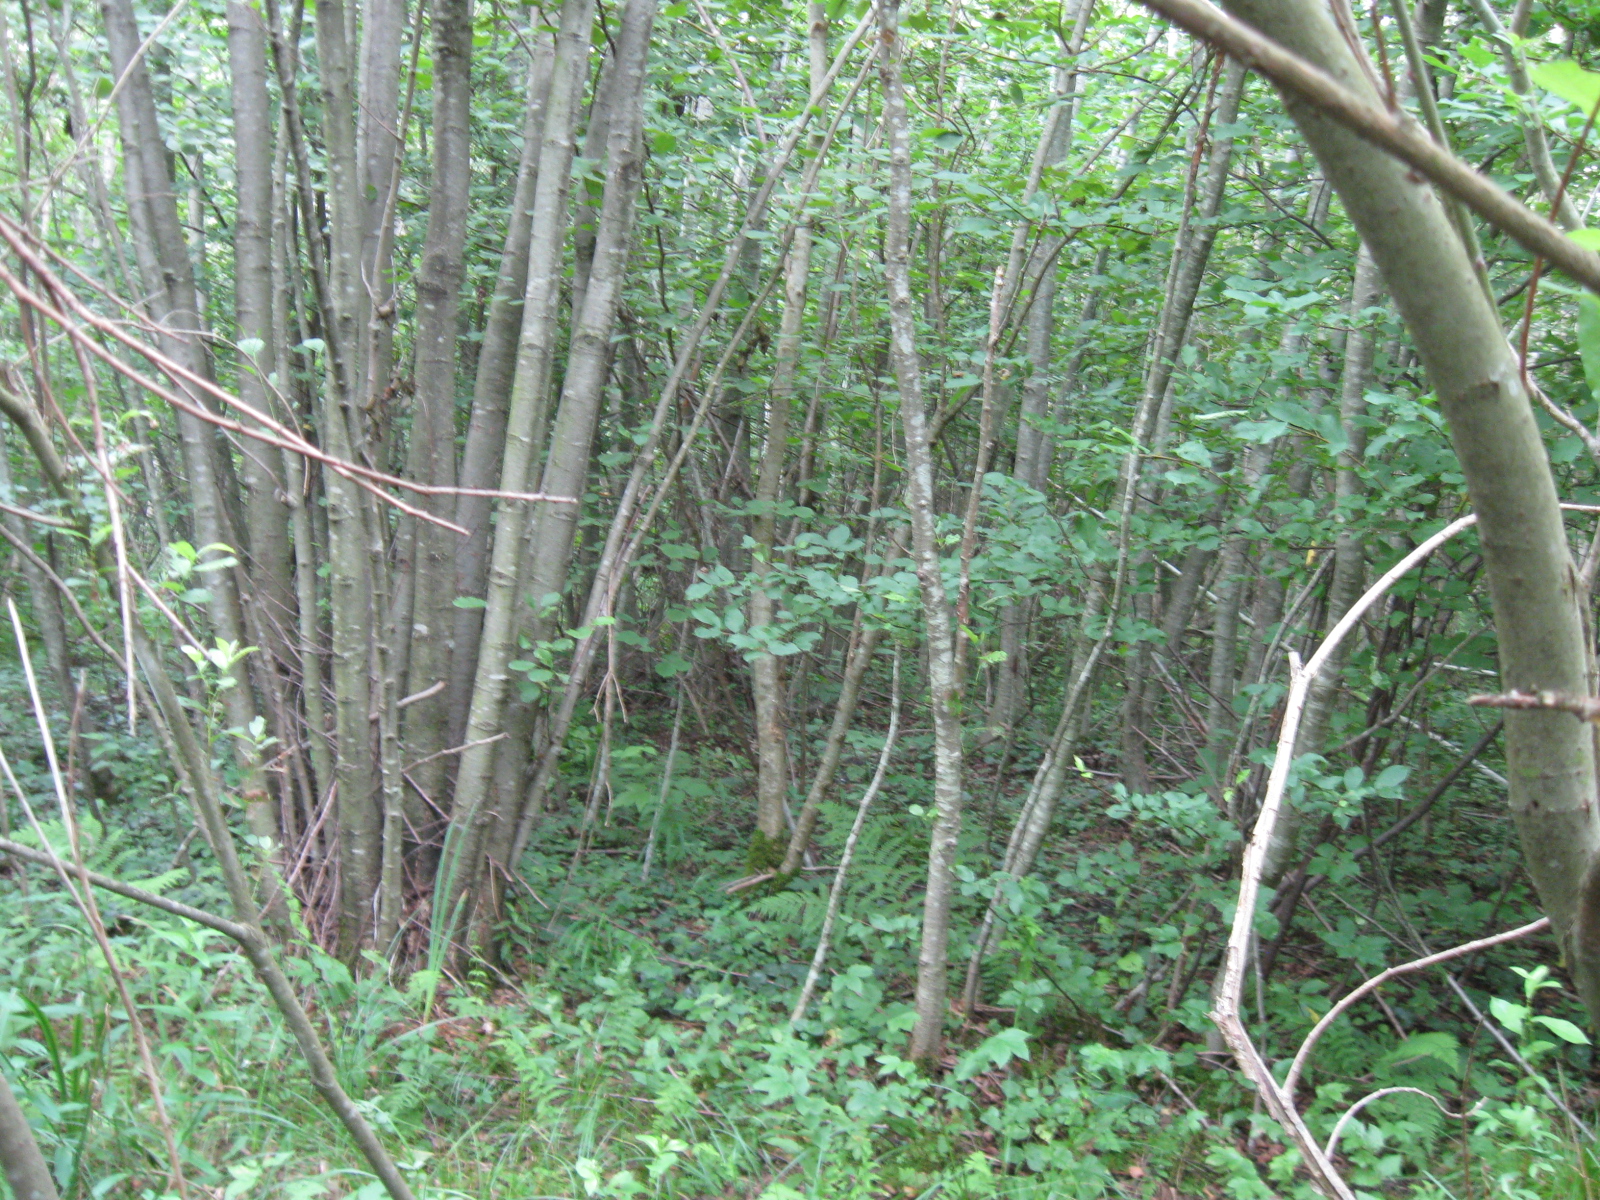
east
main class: Woodland
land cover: Broadleaved woodland
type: floodplain forest
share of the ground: > 75 %
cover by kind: broadleaved forest trees 90 %, herbaceous plants 5 %, unconsolidated bare surface 5 %
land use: Forestry
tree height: > 5 m
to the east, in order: Broadleaved woodland; Ditches and canals; Broadleaved woodland; Ditches and canals; Other mixed woodland
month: July
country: LT
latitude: 55.0622
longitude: 23.7223
